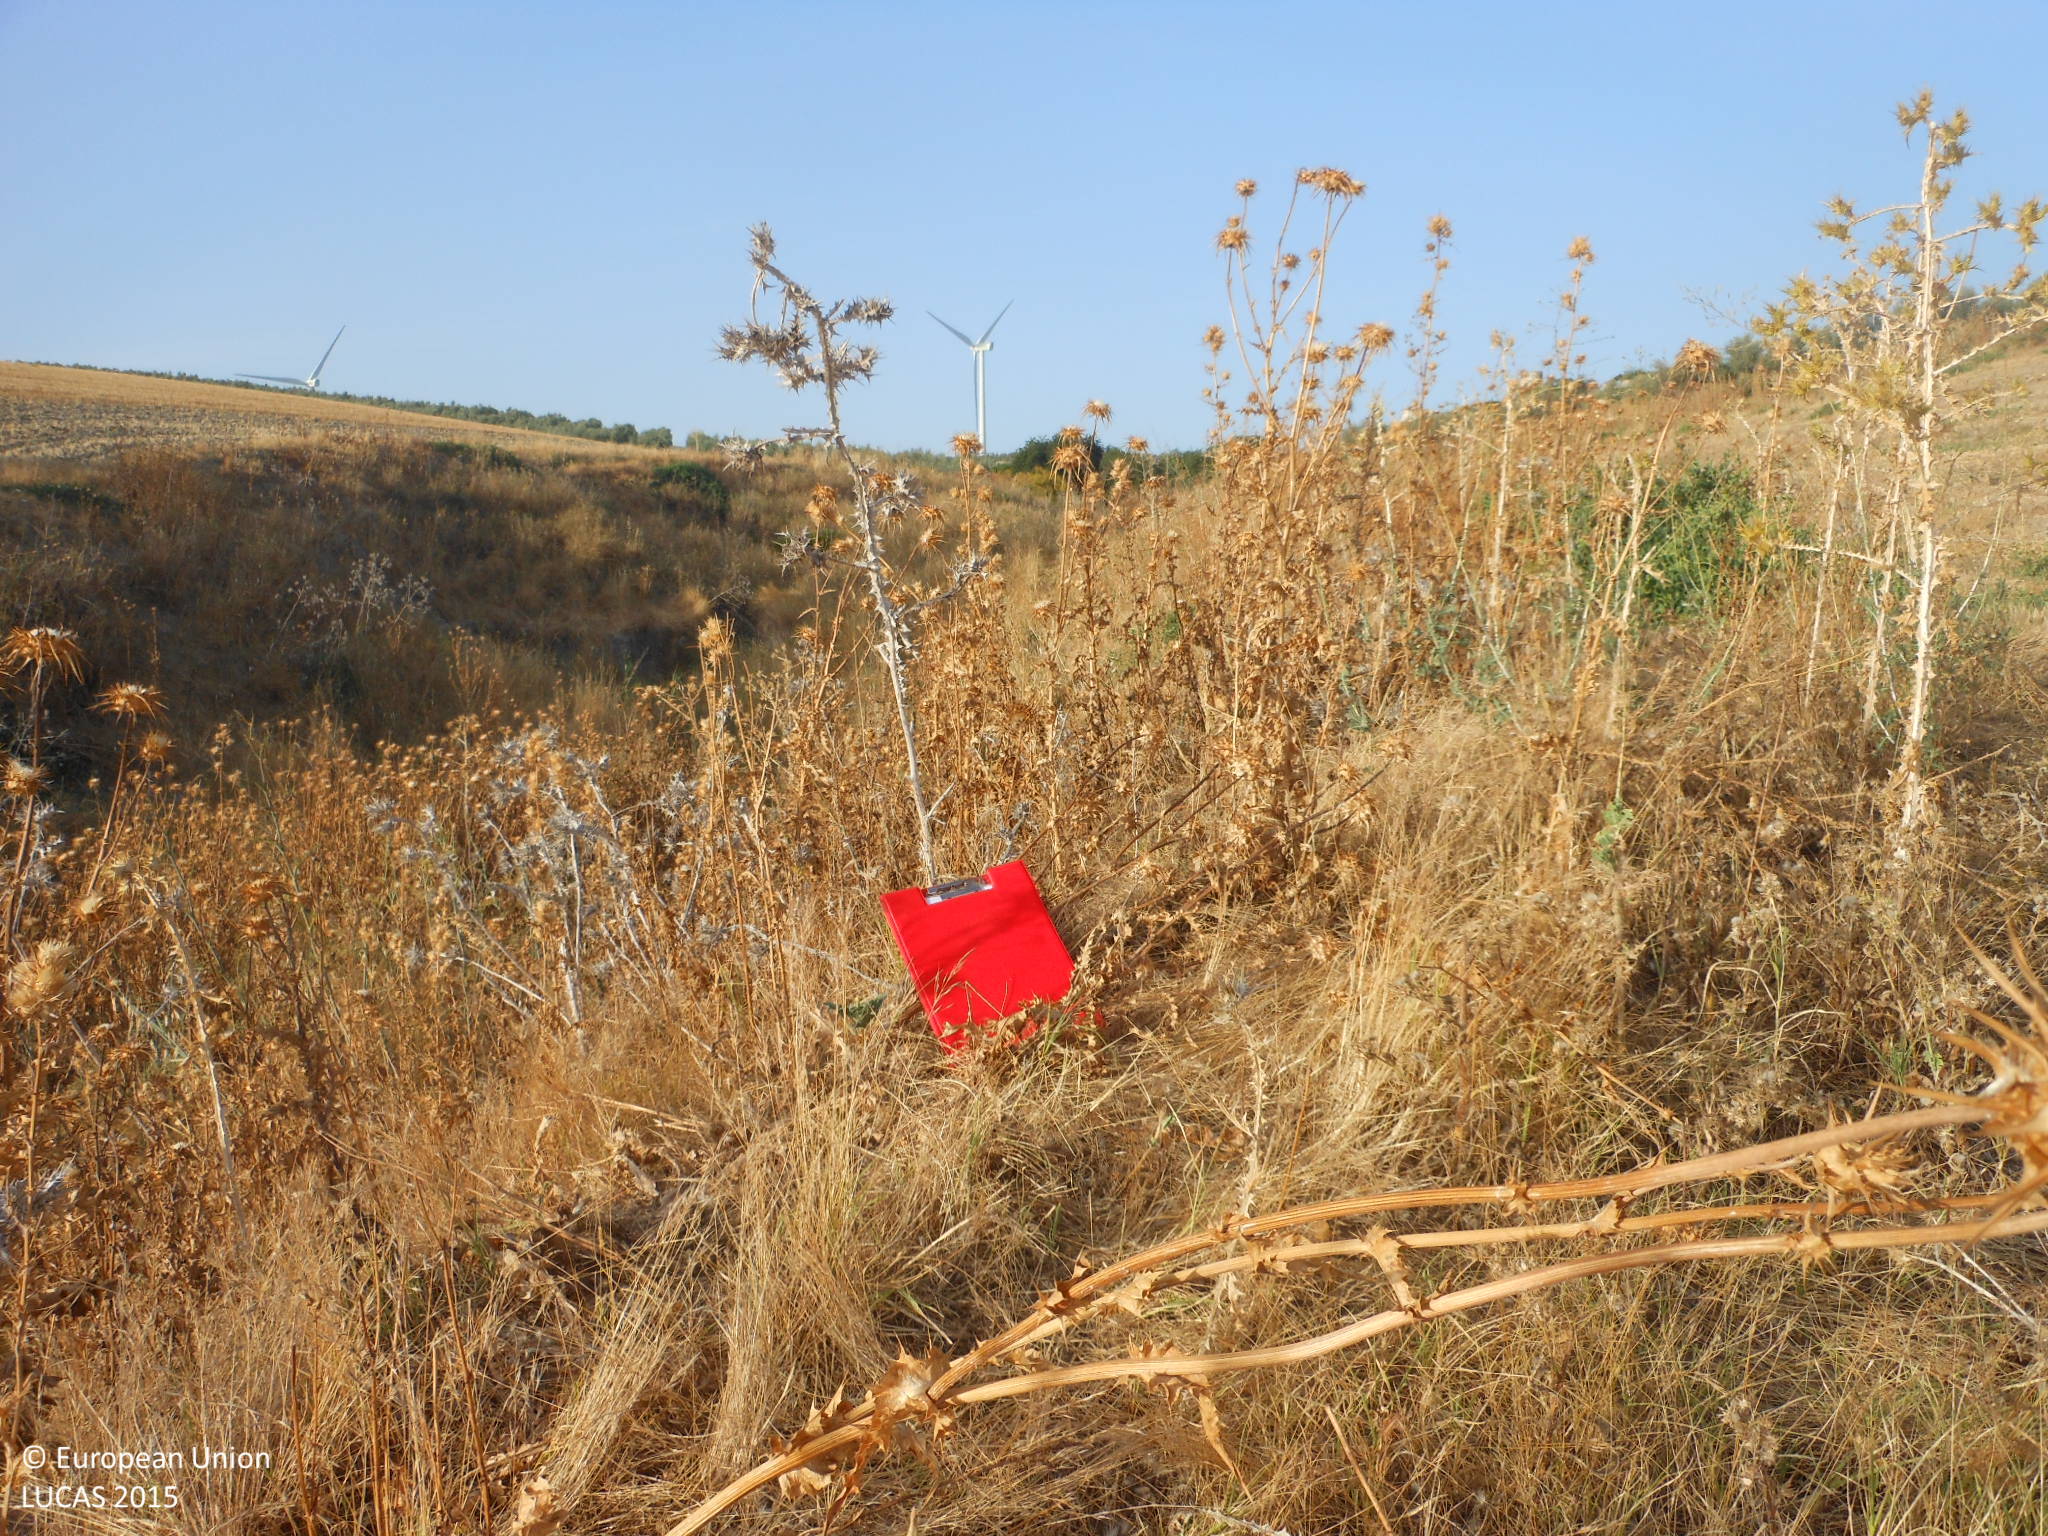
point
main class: Grassland
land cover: Grassland without tree/shrub cover
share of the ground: > 75 %
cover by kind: herbaceous plants 85 %, consolidated bare surface 15 %
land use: Semi-natural and natural areas not in use
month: July
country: ES
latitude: 37.4683
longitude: -5.1291
